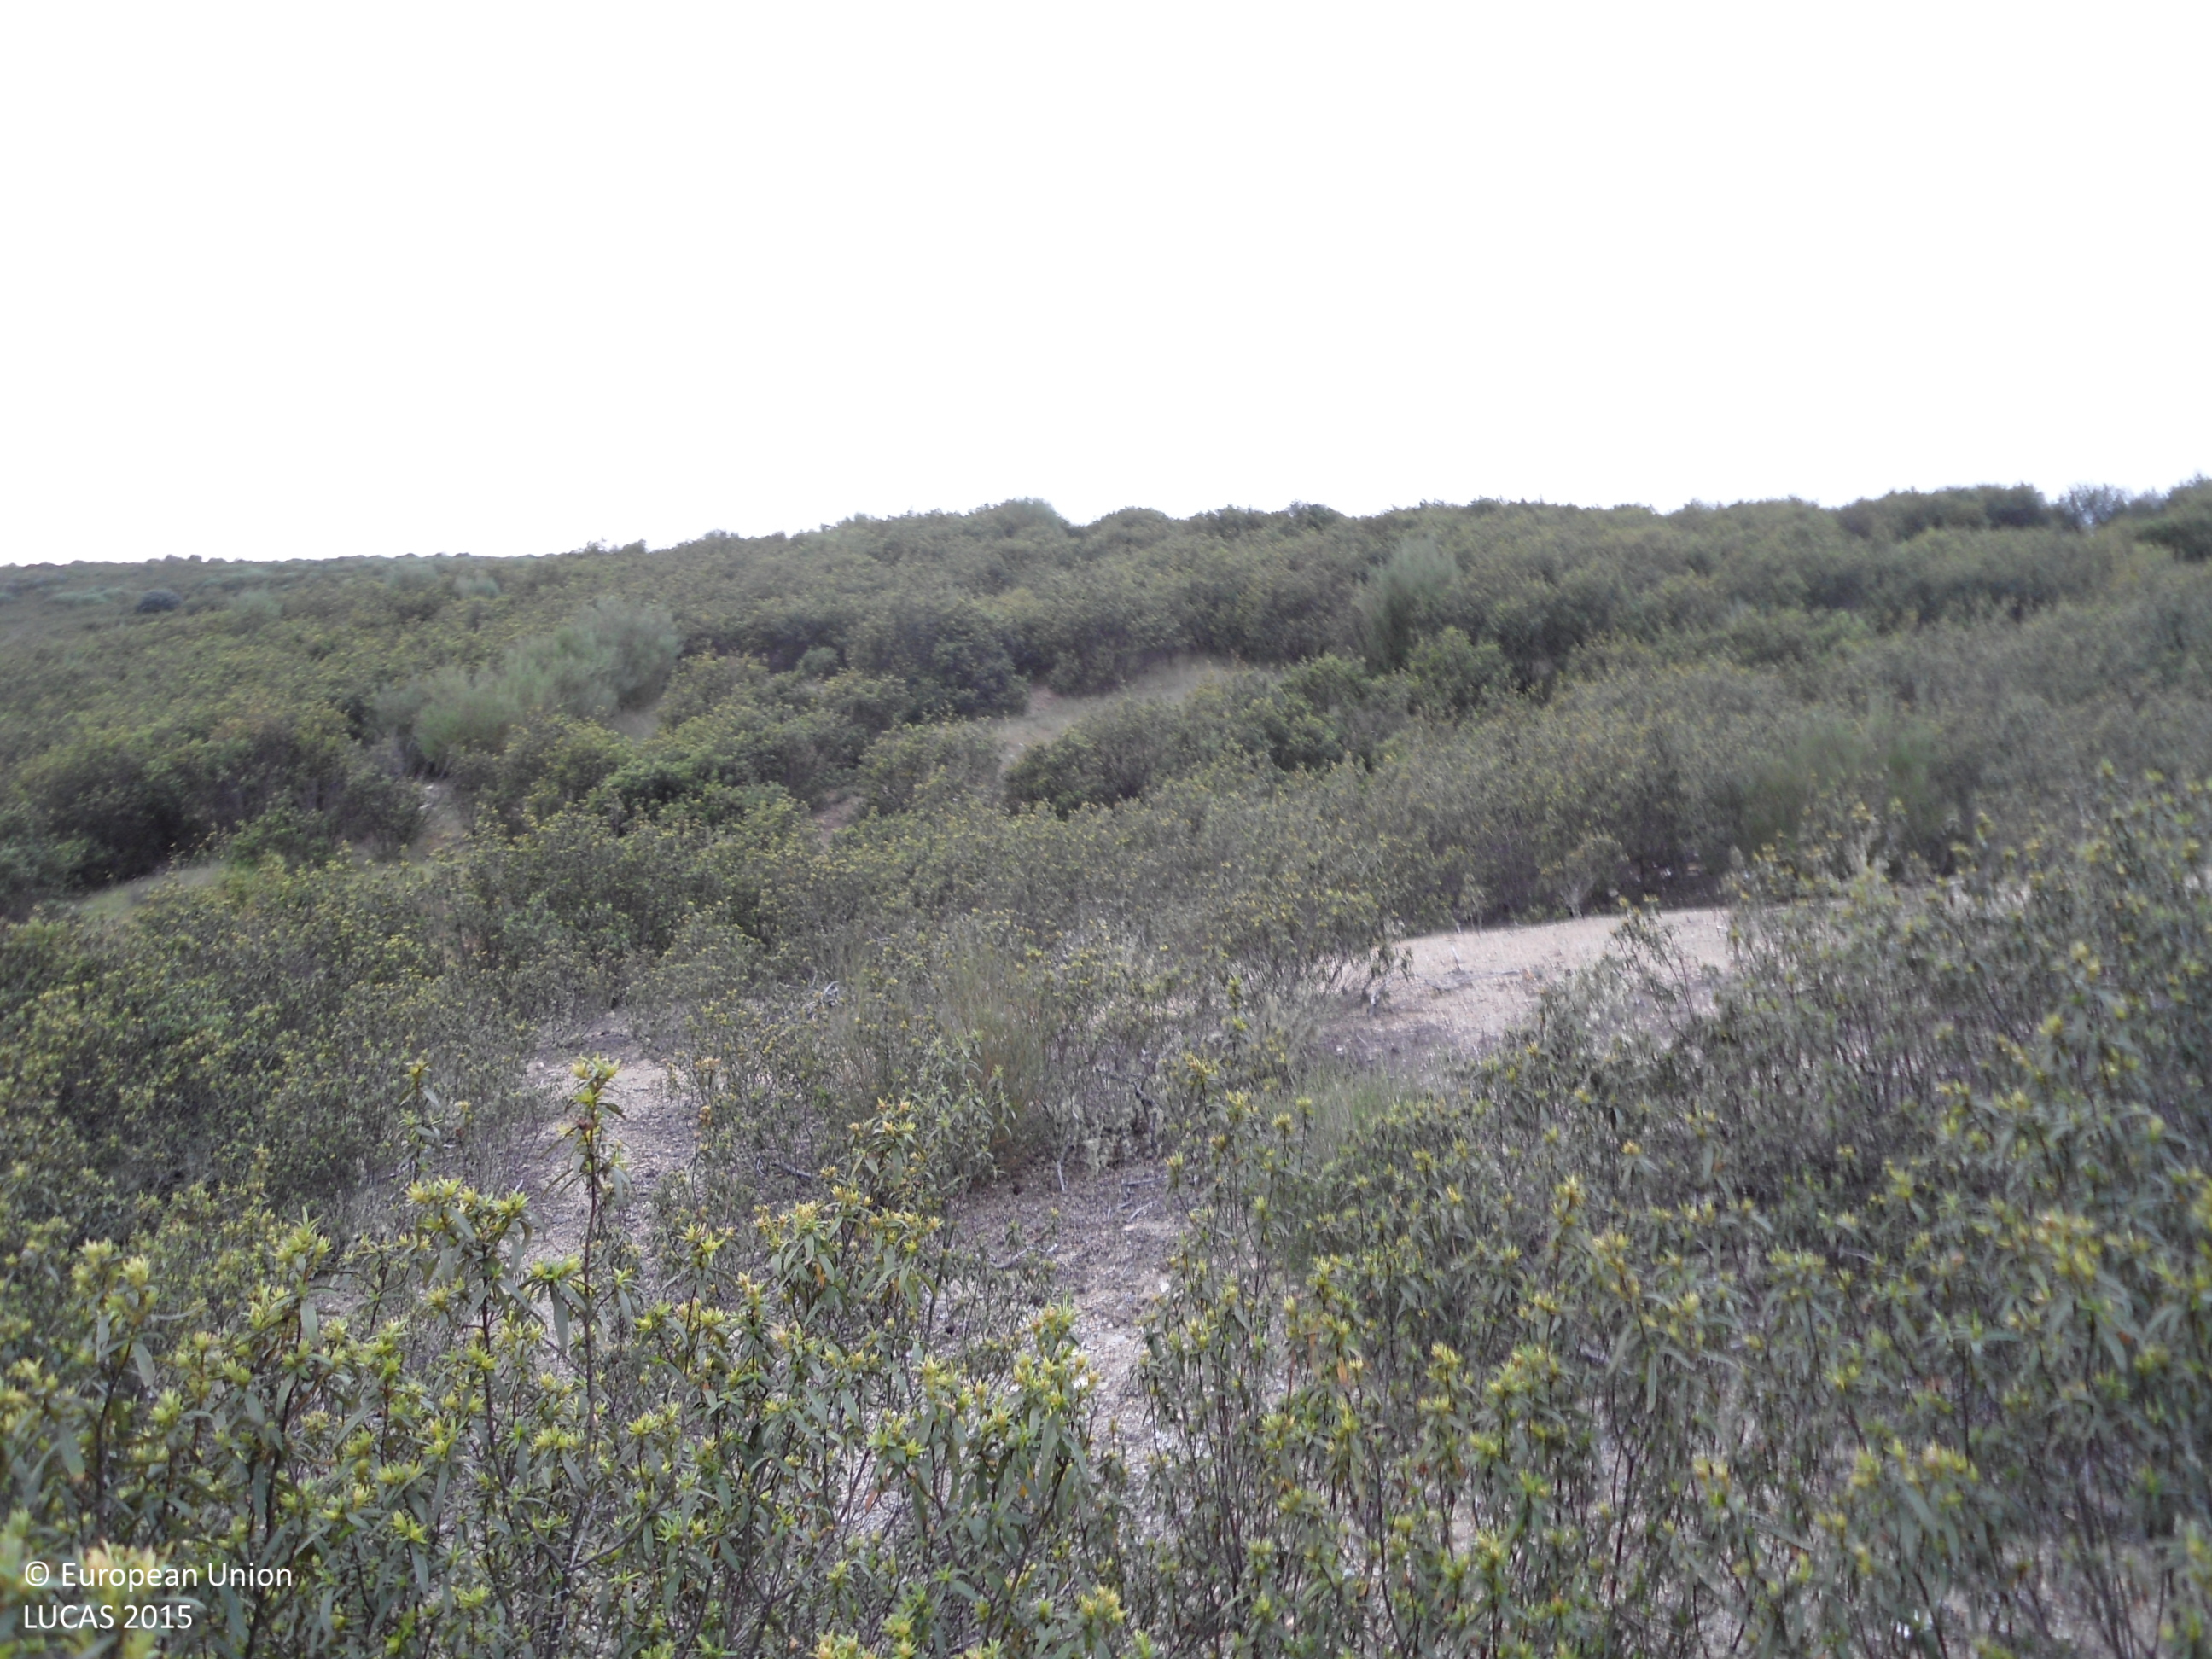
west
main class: Shrubland
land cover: Shrubland without tree cover
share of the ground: > 75 %
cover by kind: shrubs 95 %, consolidated bare surface 5 %
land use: Semi-natural and natural areas not in use
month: April
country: ES
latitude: 41.7893
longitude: -6.4836
